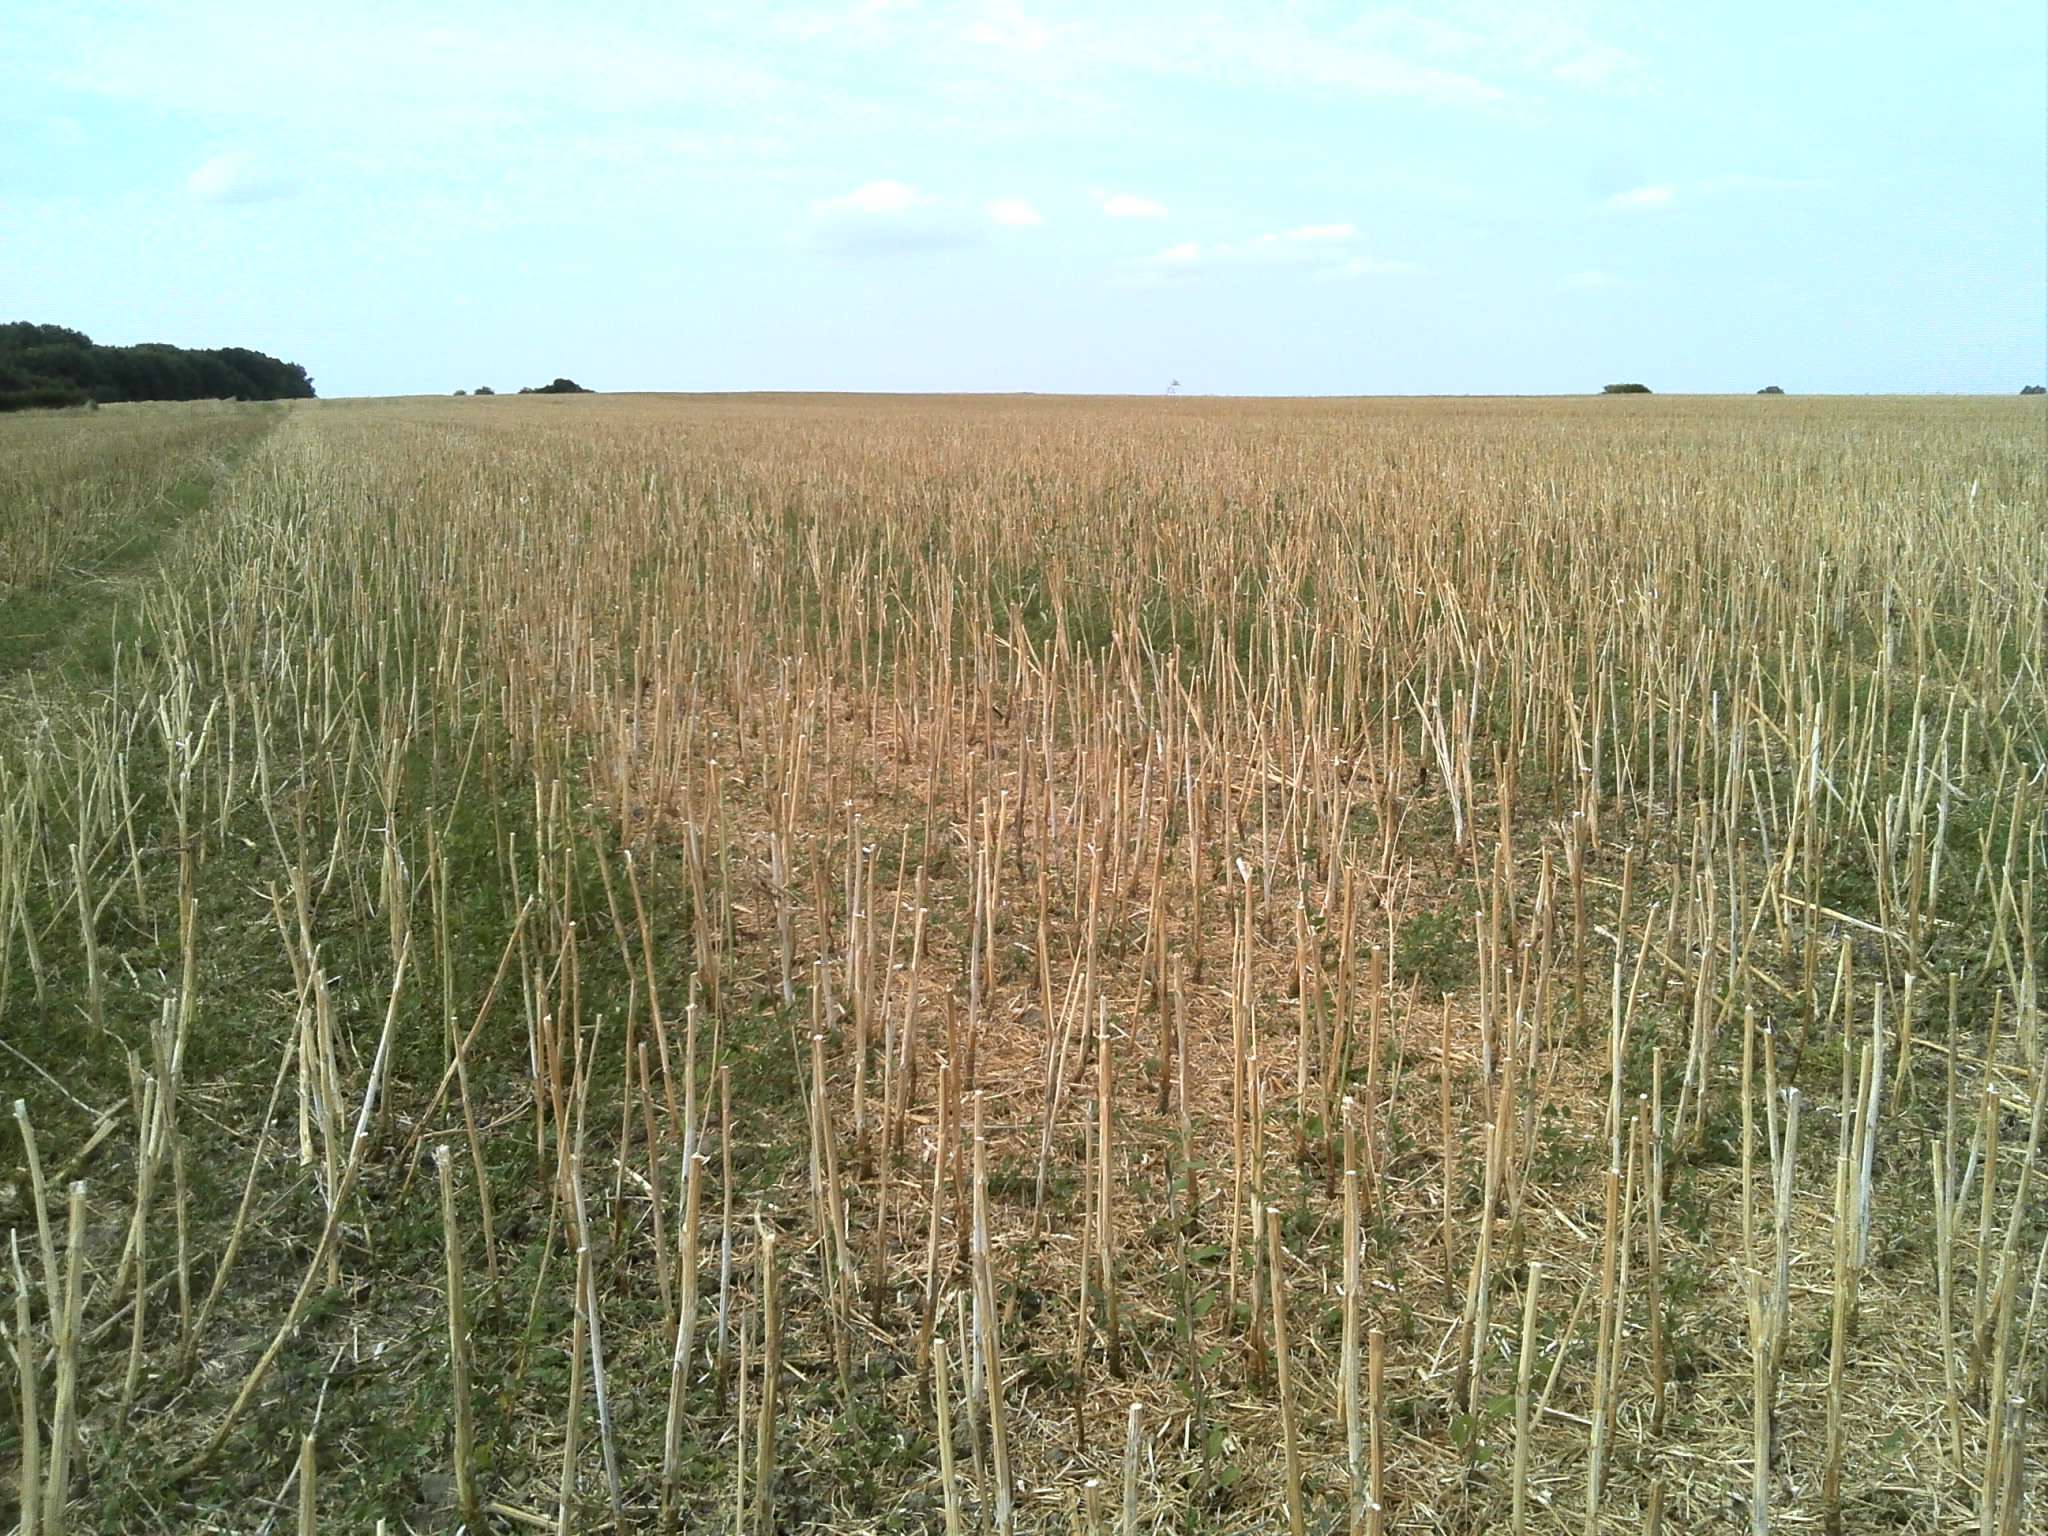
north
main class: Cropland
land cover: Rape and turnip rape
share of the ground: < 10 %
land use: Agriculture (excluding fallow land and kitchen gardens)
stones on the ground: < 10 %
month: July
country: FR
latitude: 46.6984
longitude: 1.4751
